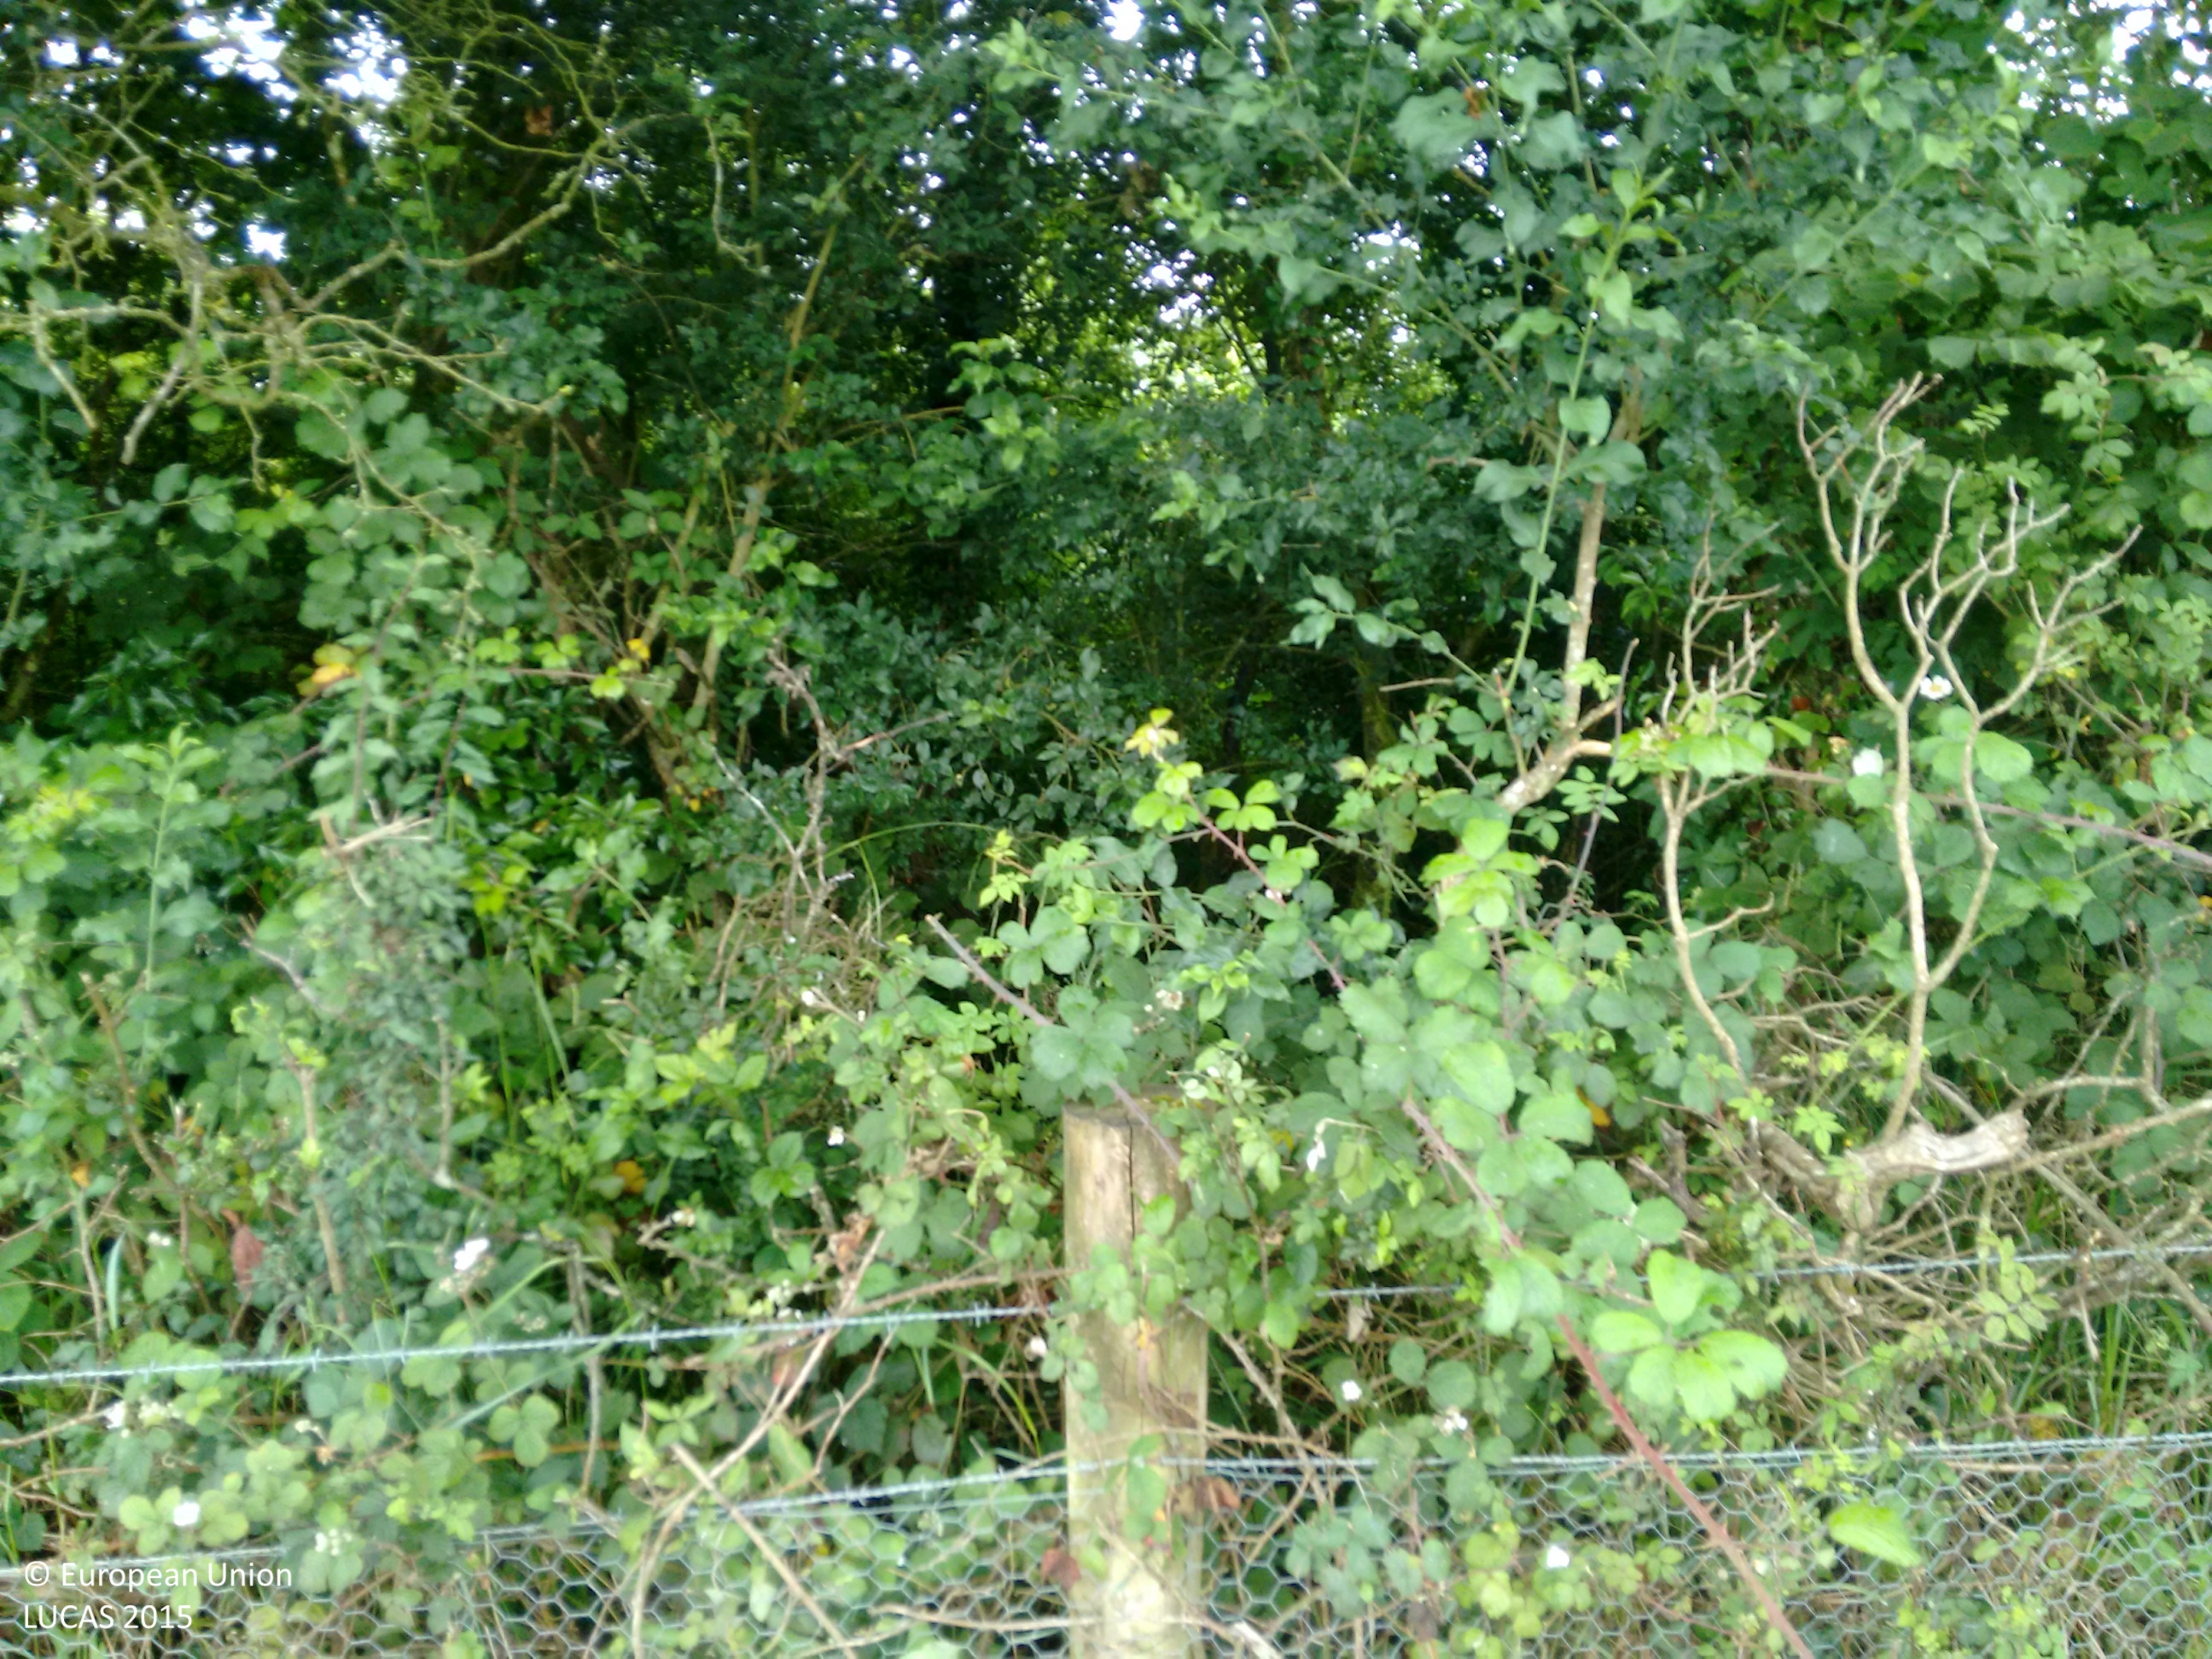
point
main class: Grassland
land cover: Grassland without tree/shrub cover
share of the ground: > 75 %
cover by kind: herbaceous plants 100 %
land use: Agriculture (excluding fallow land and kitchen gardens)
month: July
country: IE
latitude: 52.6171
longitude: -7.4532
